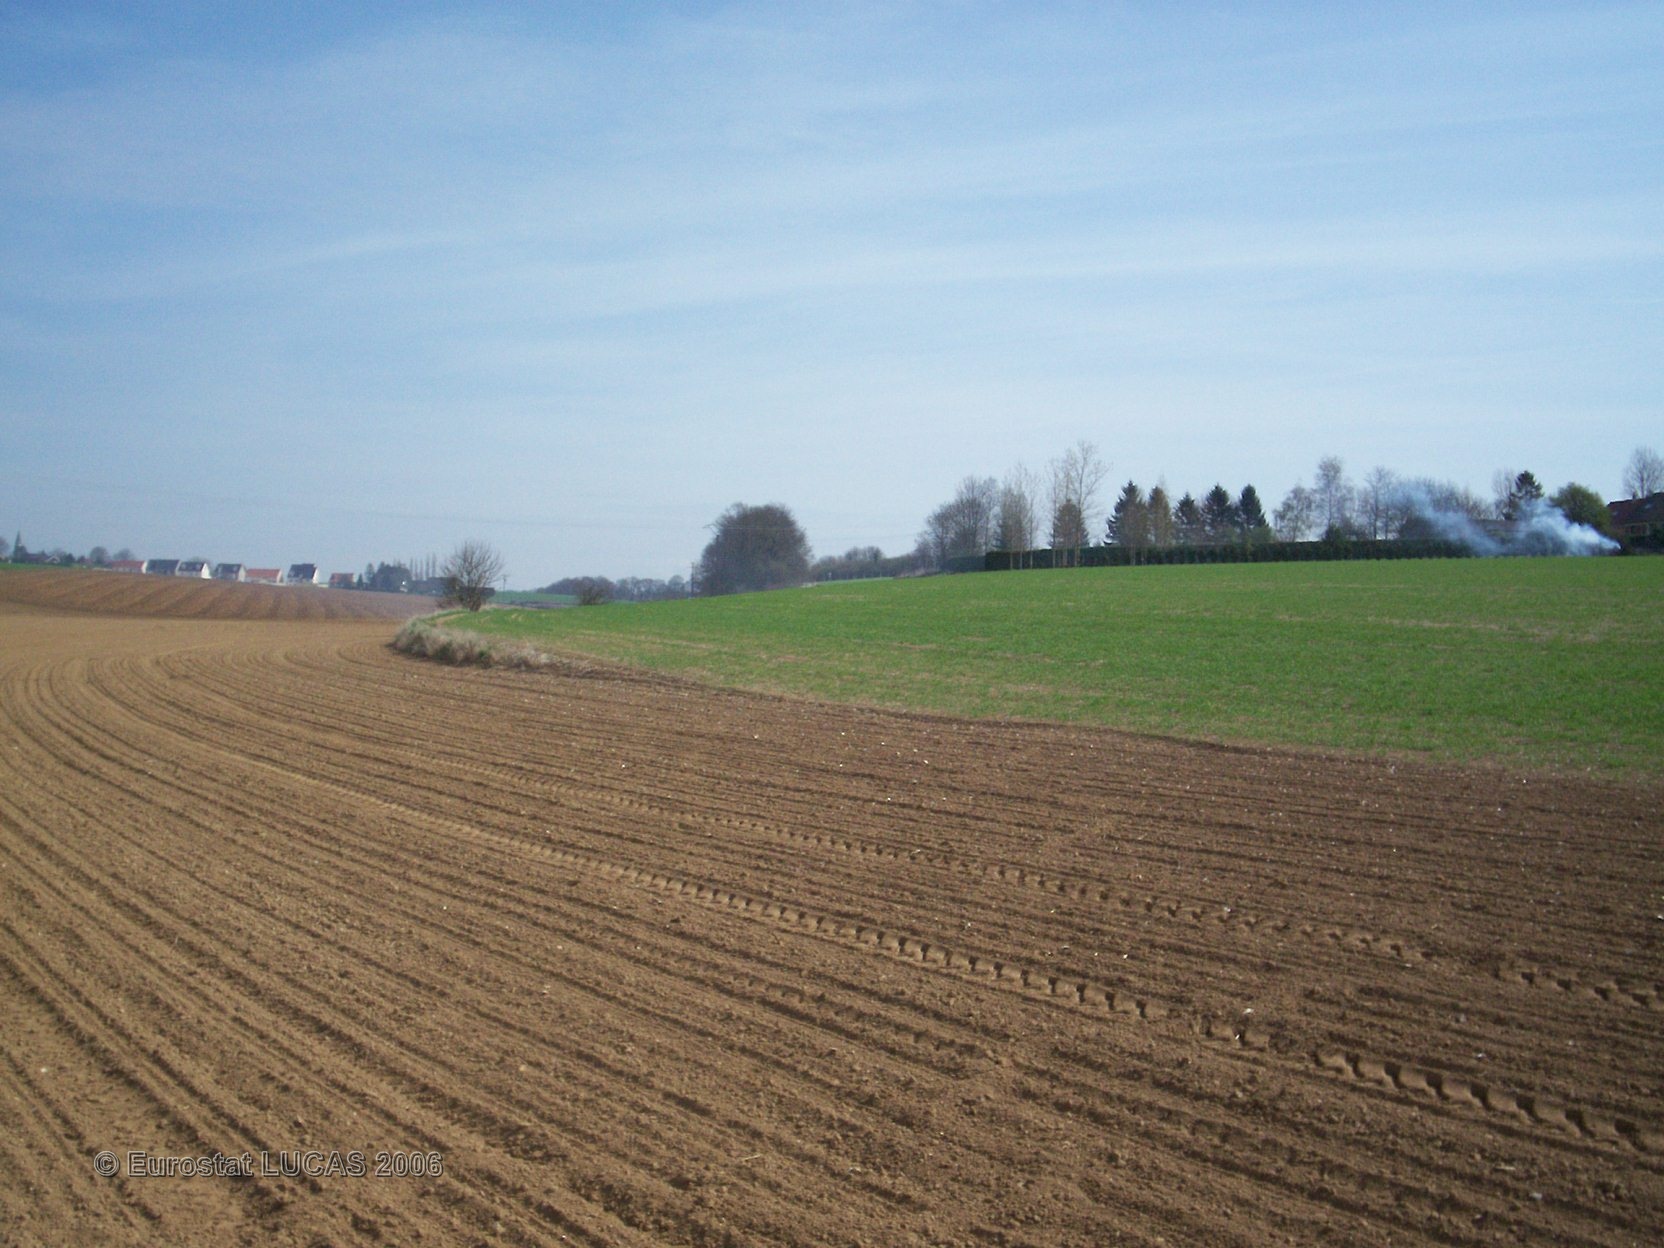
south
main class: Cropland
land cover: Sugar beet
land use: Agriculture (excluding fallow land and kitchen gardens)
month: April
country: FR
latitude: 50.0216
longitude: 2.6889
